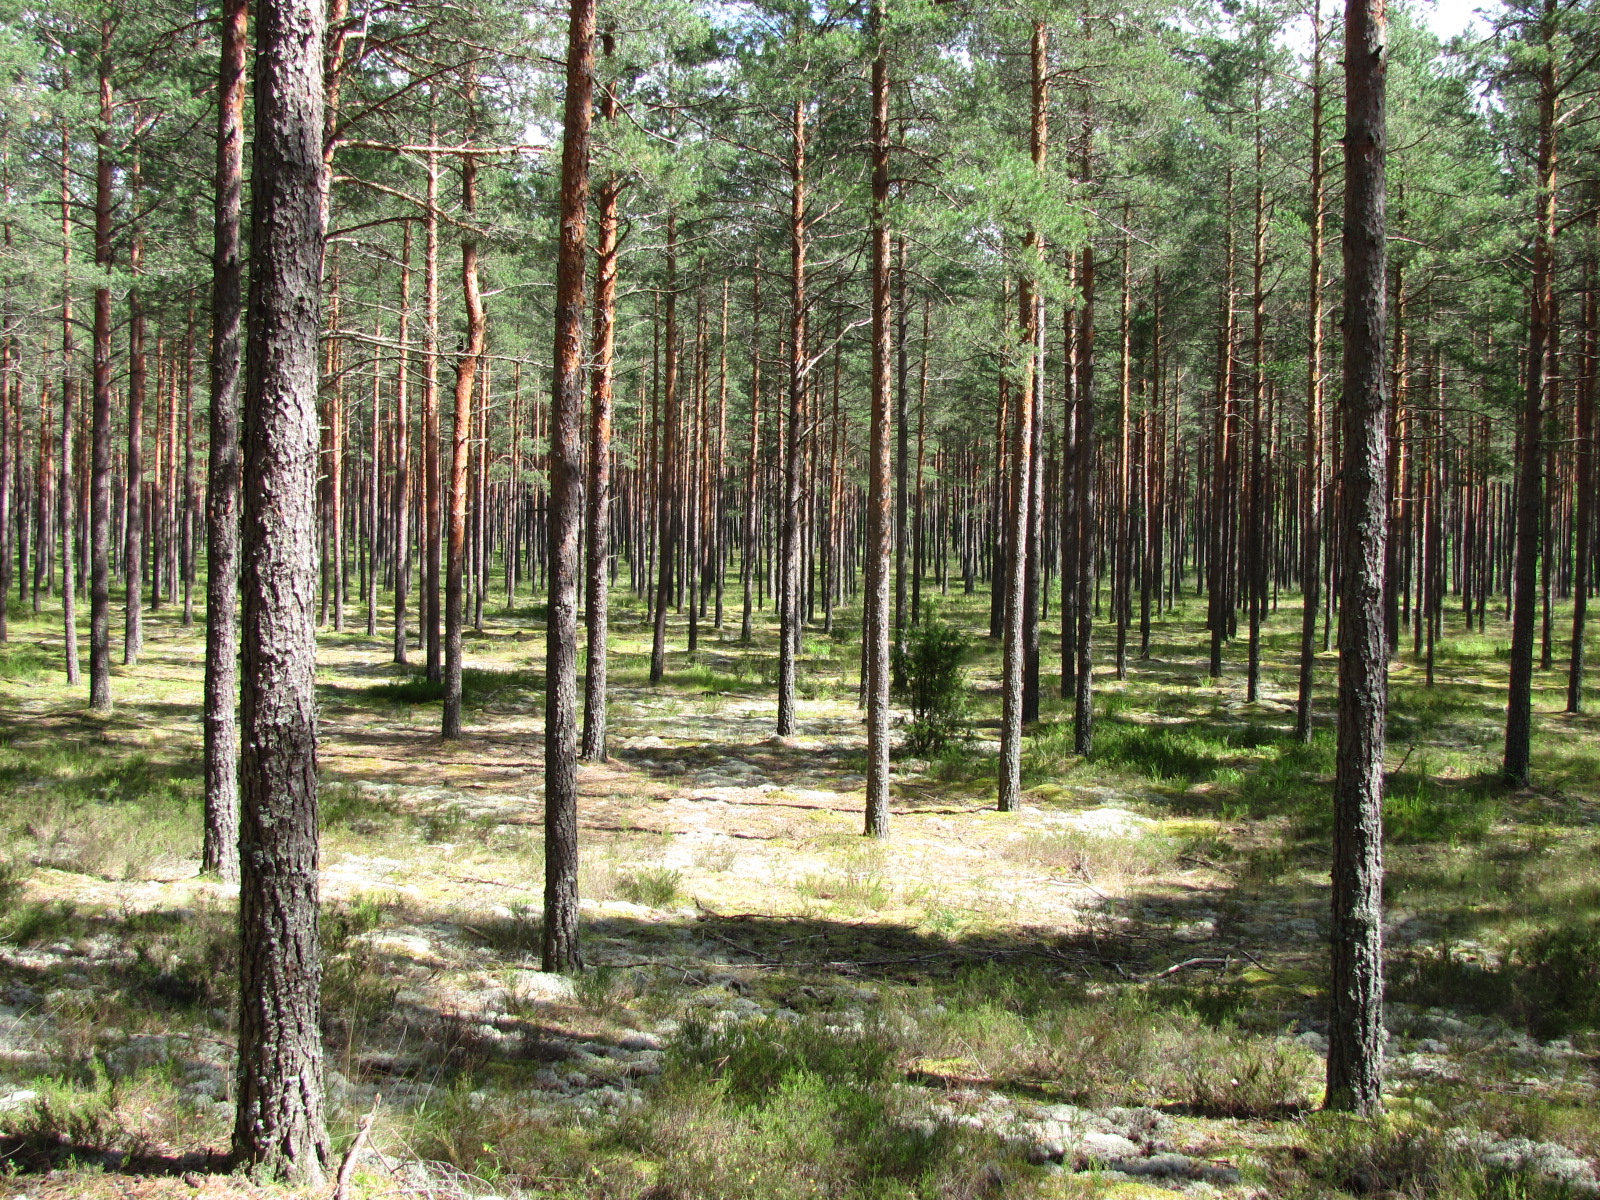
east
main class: Woodland
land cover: Pine dominated coniferous woodland
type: hemiboreal forest and nemoral coniferous forest and mixed broadleaved-coniferous forest
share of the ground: > 75 %
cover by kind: coniferous forest trees 80 %, lichens and mosses 15 %, shrubs 5 %
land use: Forestry
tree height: > 5 m
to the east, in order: Pine dominated coniferous woodland; Tracks; Pine dominated coniferous woodland
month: July
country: LV
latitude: 57.0201
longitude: 24.3715
